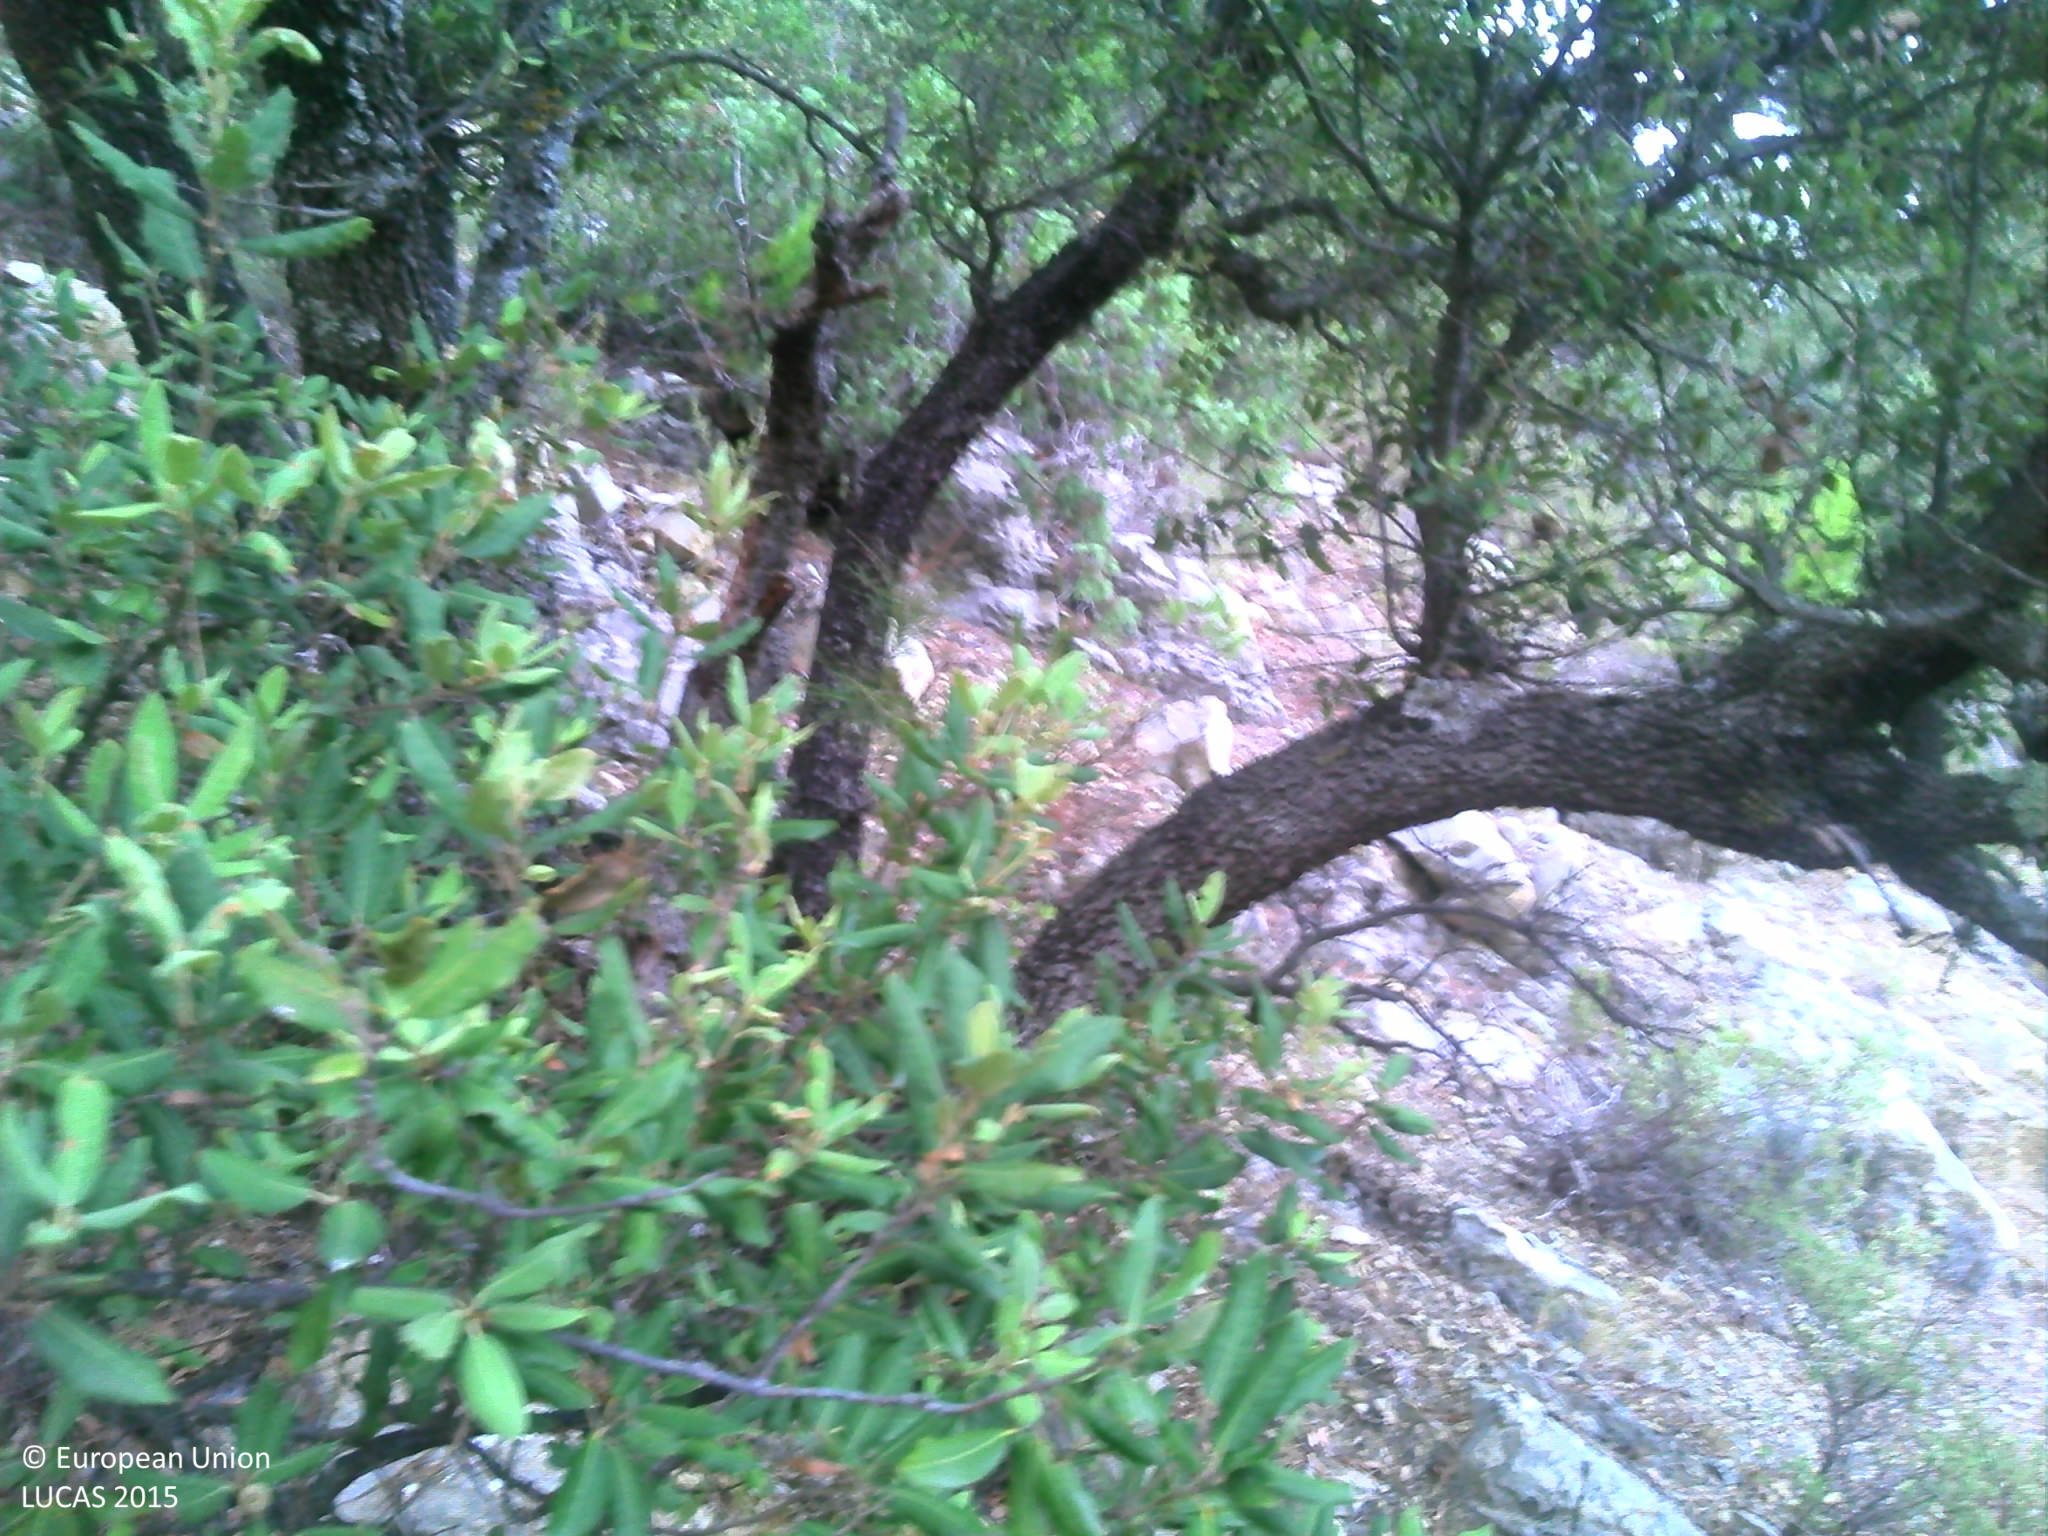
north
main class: Woodland
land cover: Pine dominated mixed woodland
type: thermophilous deciduous forest
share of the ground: > 75 %
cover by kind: coniferous forest trees 30 %, broadleaved forest trees 30 %, unconsolidated bare surface 20 %, shrubs 10 %, herbaceous plants 10 %
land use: Semi-natural and natural areas not in use
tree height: > 5 m
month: August
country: FR
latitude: 43.5523
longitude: 5.5905
